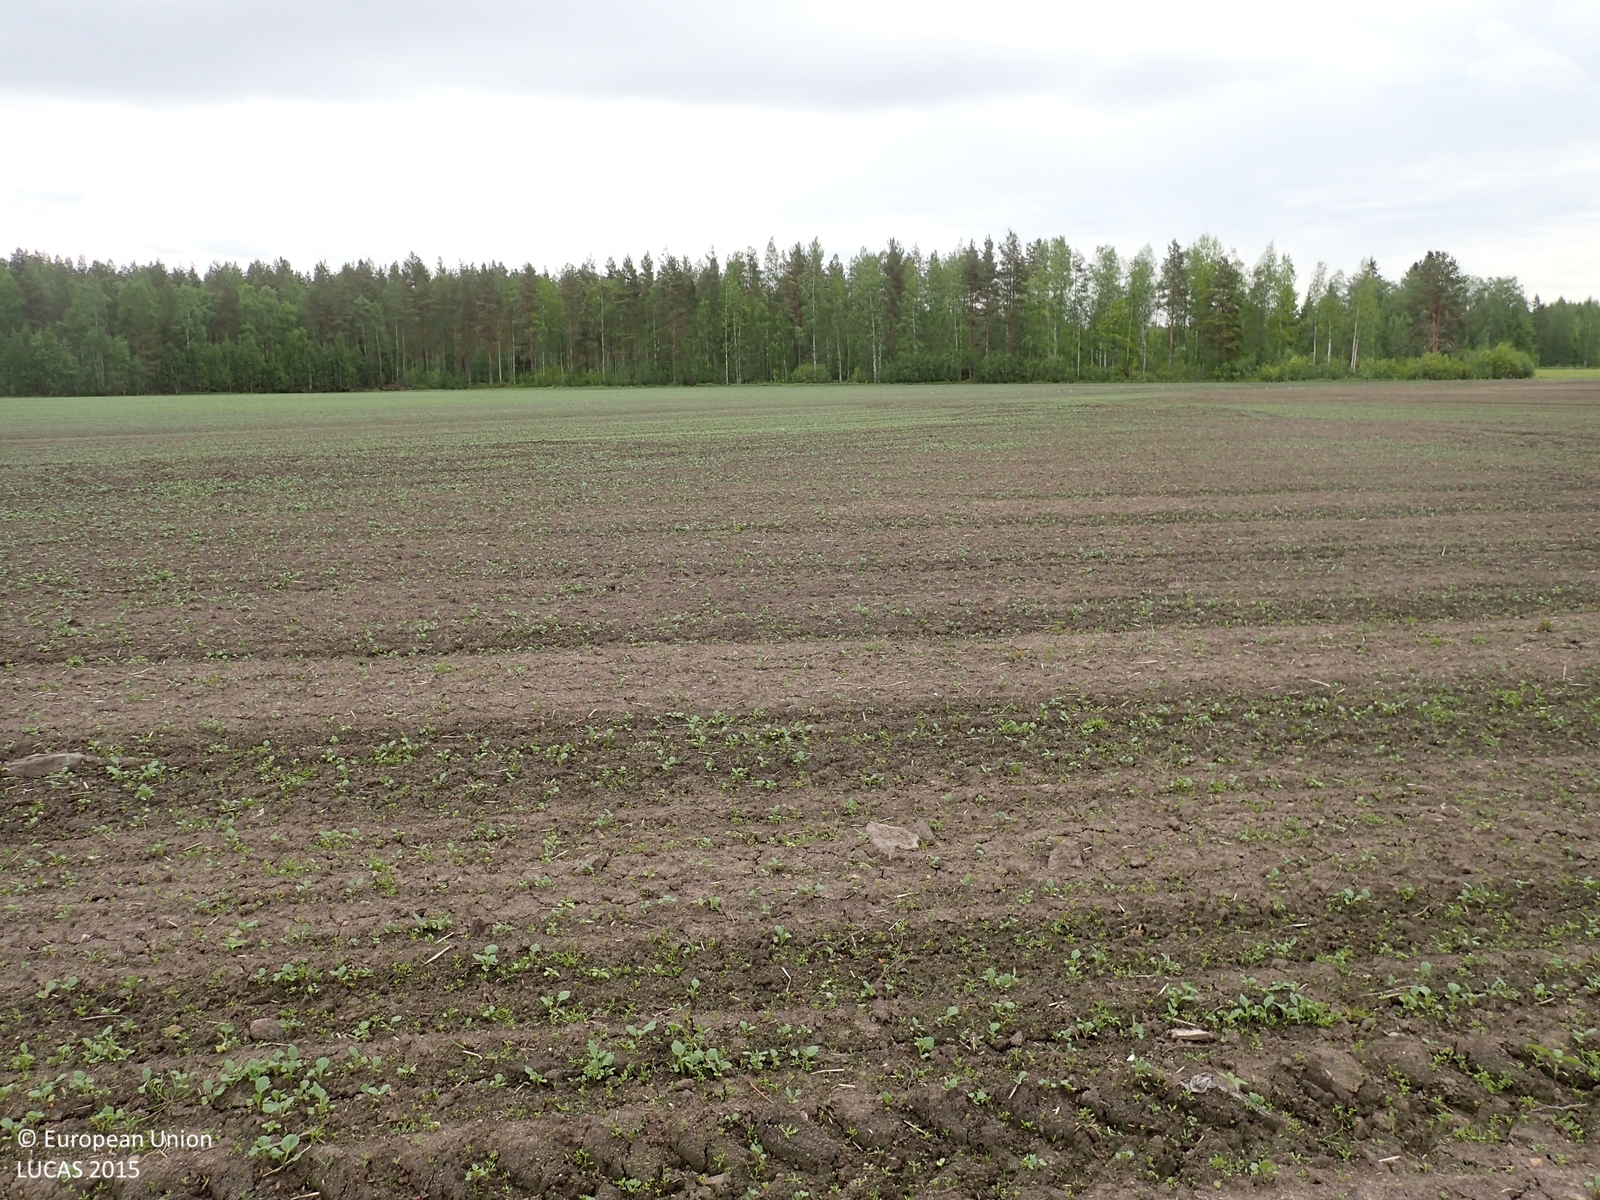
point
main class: Cropland
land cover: Rape and turnip rape
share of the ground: 25 - 50 %
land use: Agriculture (excluding fallow land and kitchen gardens)
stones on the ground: < 10 %
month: June
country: FI
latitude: 62.2525
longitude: 22.5148
